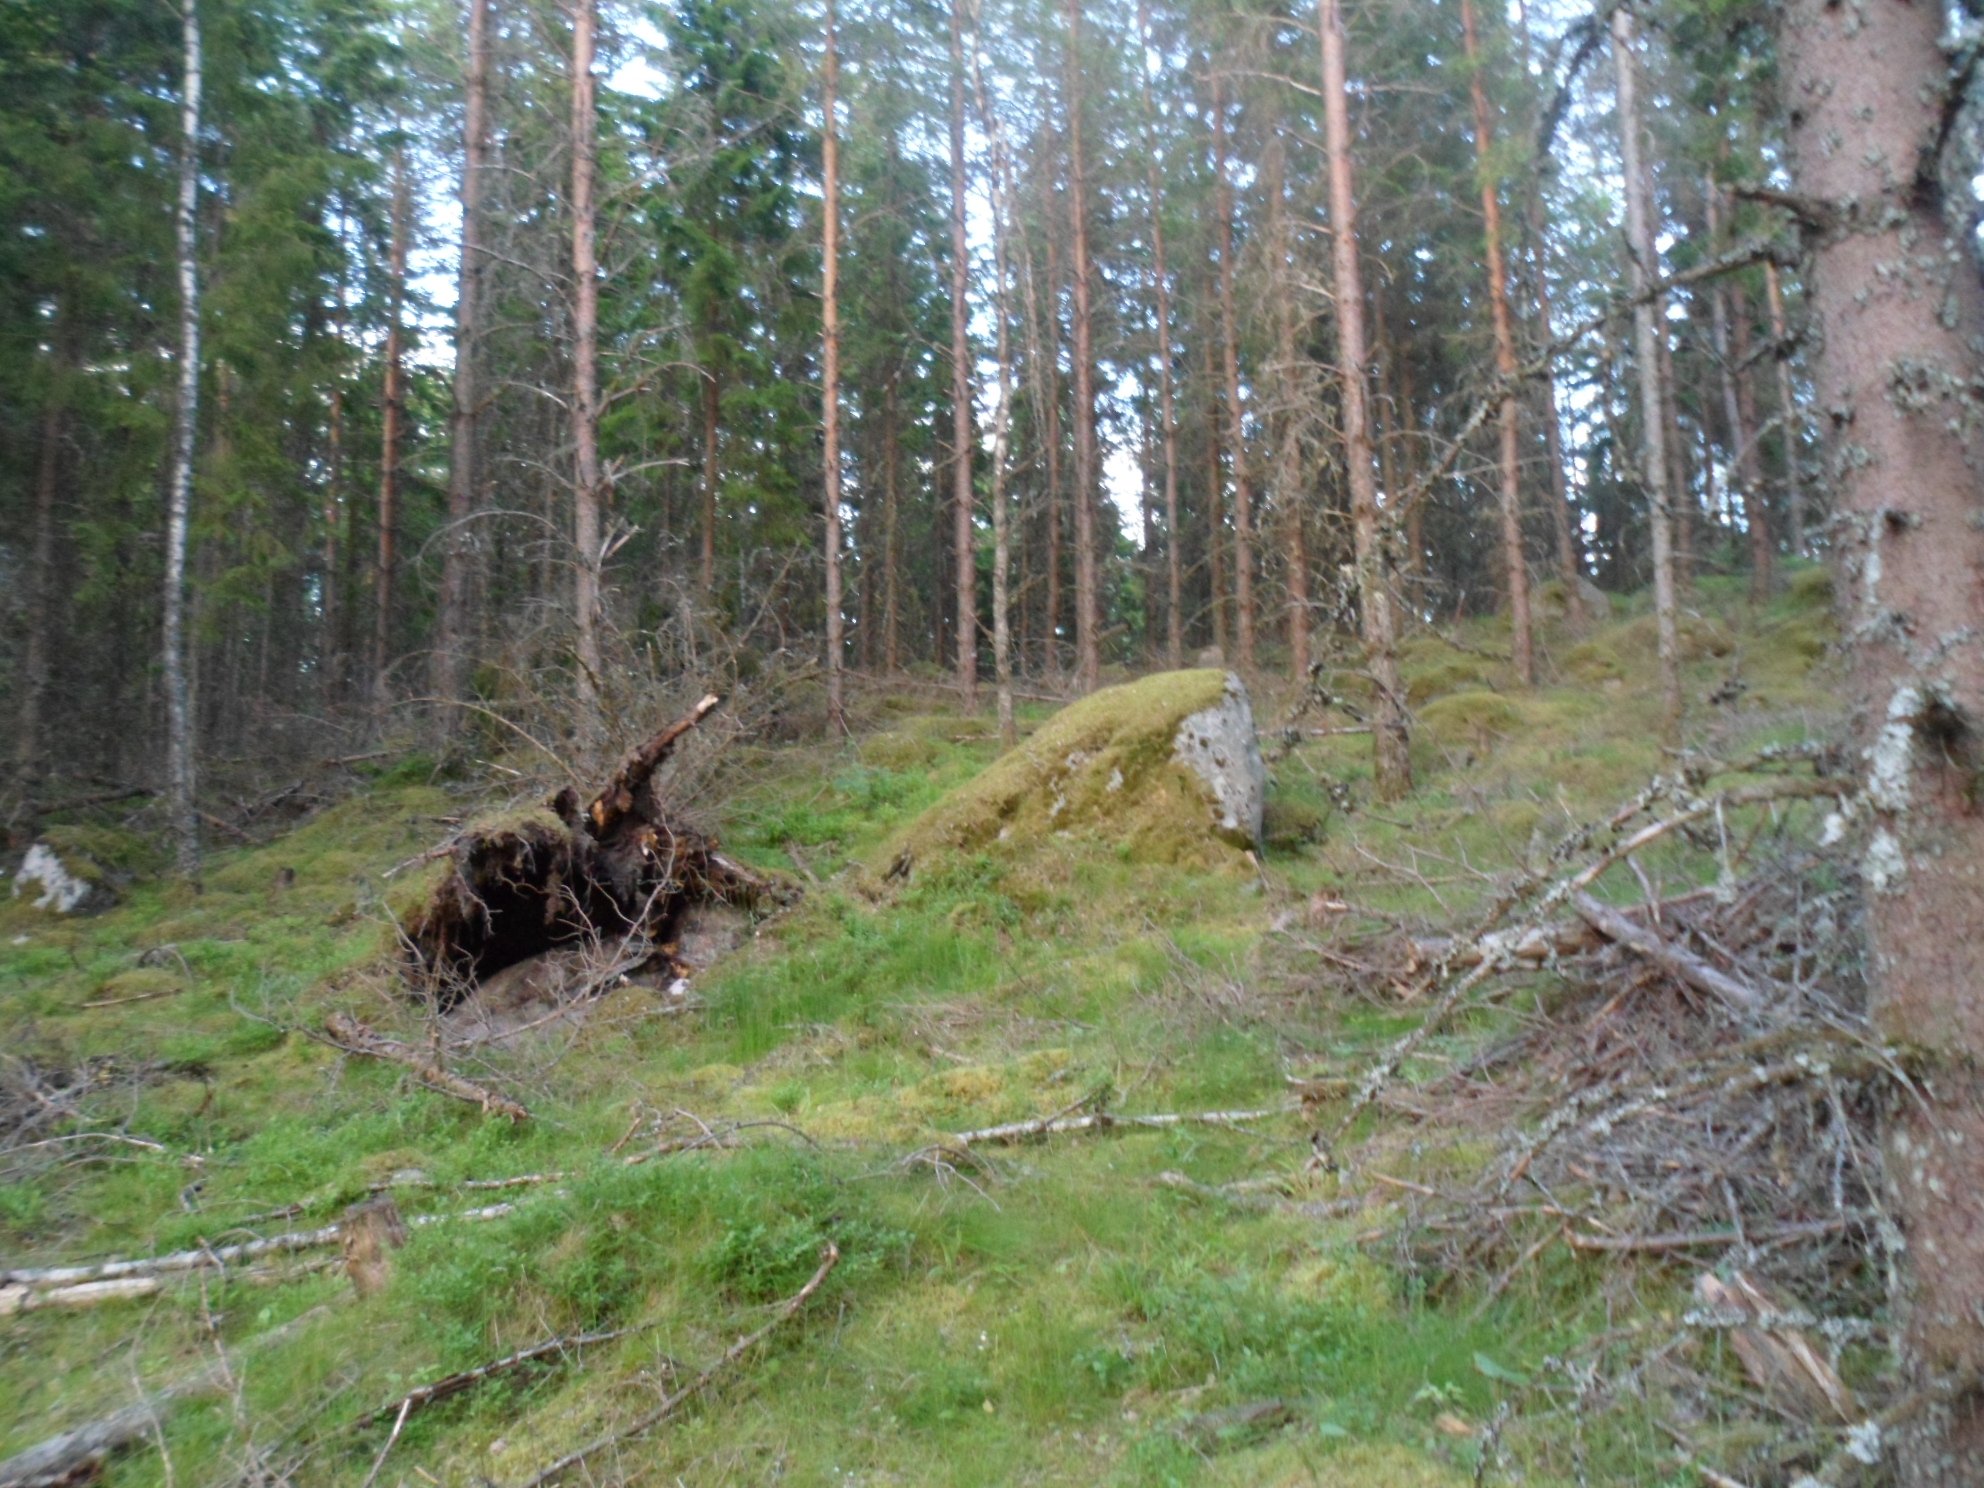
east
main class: Woodland
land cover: Spruce dominated coniferous woodland
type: boreal forest
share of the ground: 50 - 75 %
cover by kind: coniferous forest trees 55 %, herbaceous plants 15 %, broadleaved forest trees 10 %, shrubs 10 %, lichens and mosses 10 %
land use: Forestry
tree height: > 5 m
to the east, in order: Spruce dominated coniferous woodland; Pine dominated coniferous woodland; Tracks; Pine dominated coniferous woodland; Tracks; Pine dominated coniferous woodland; Spruce dominated coniferous woodland
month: July
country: SE
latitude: 57.2103
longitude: 14.4167
